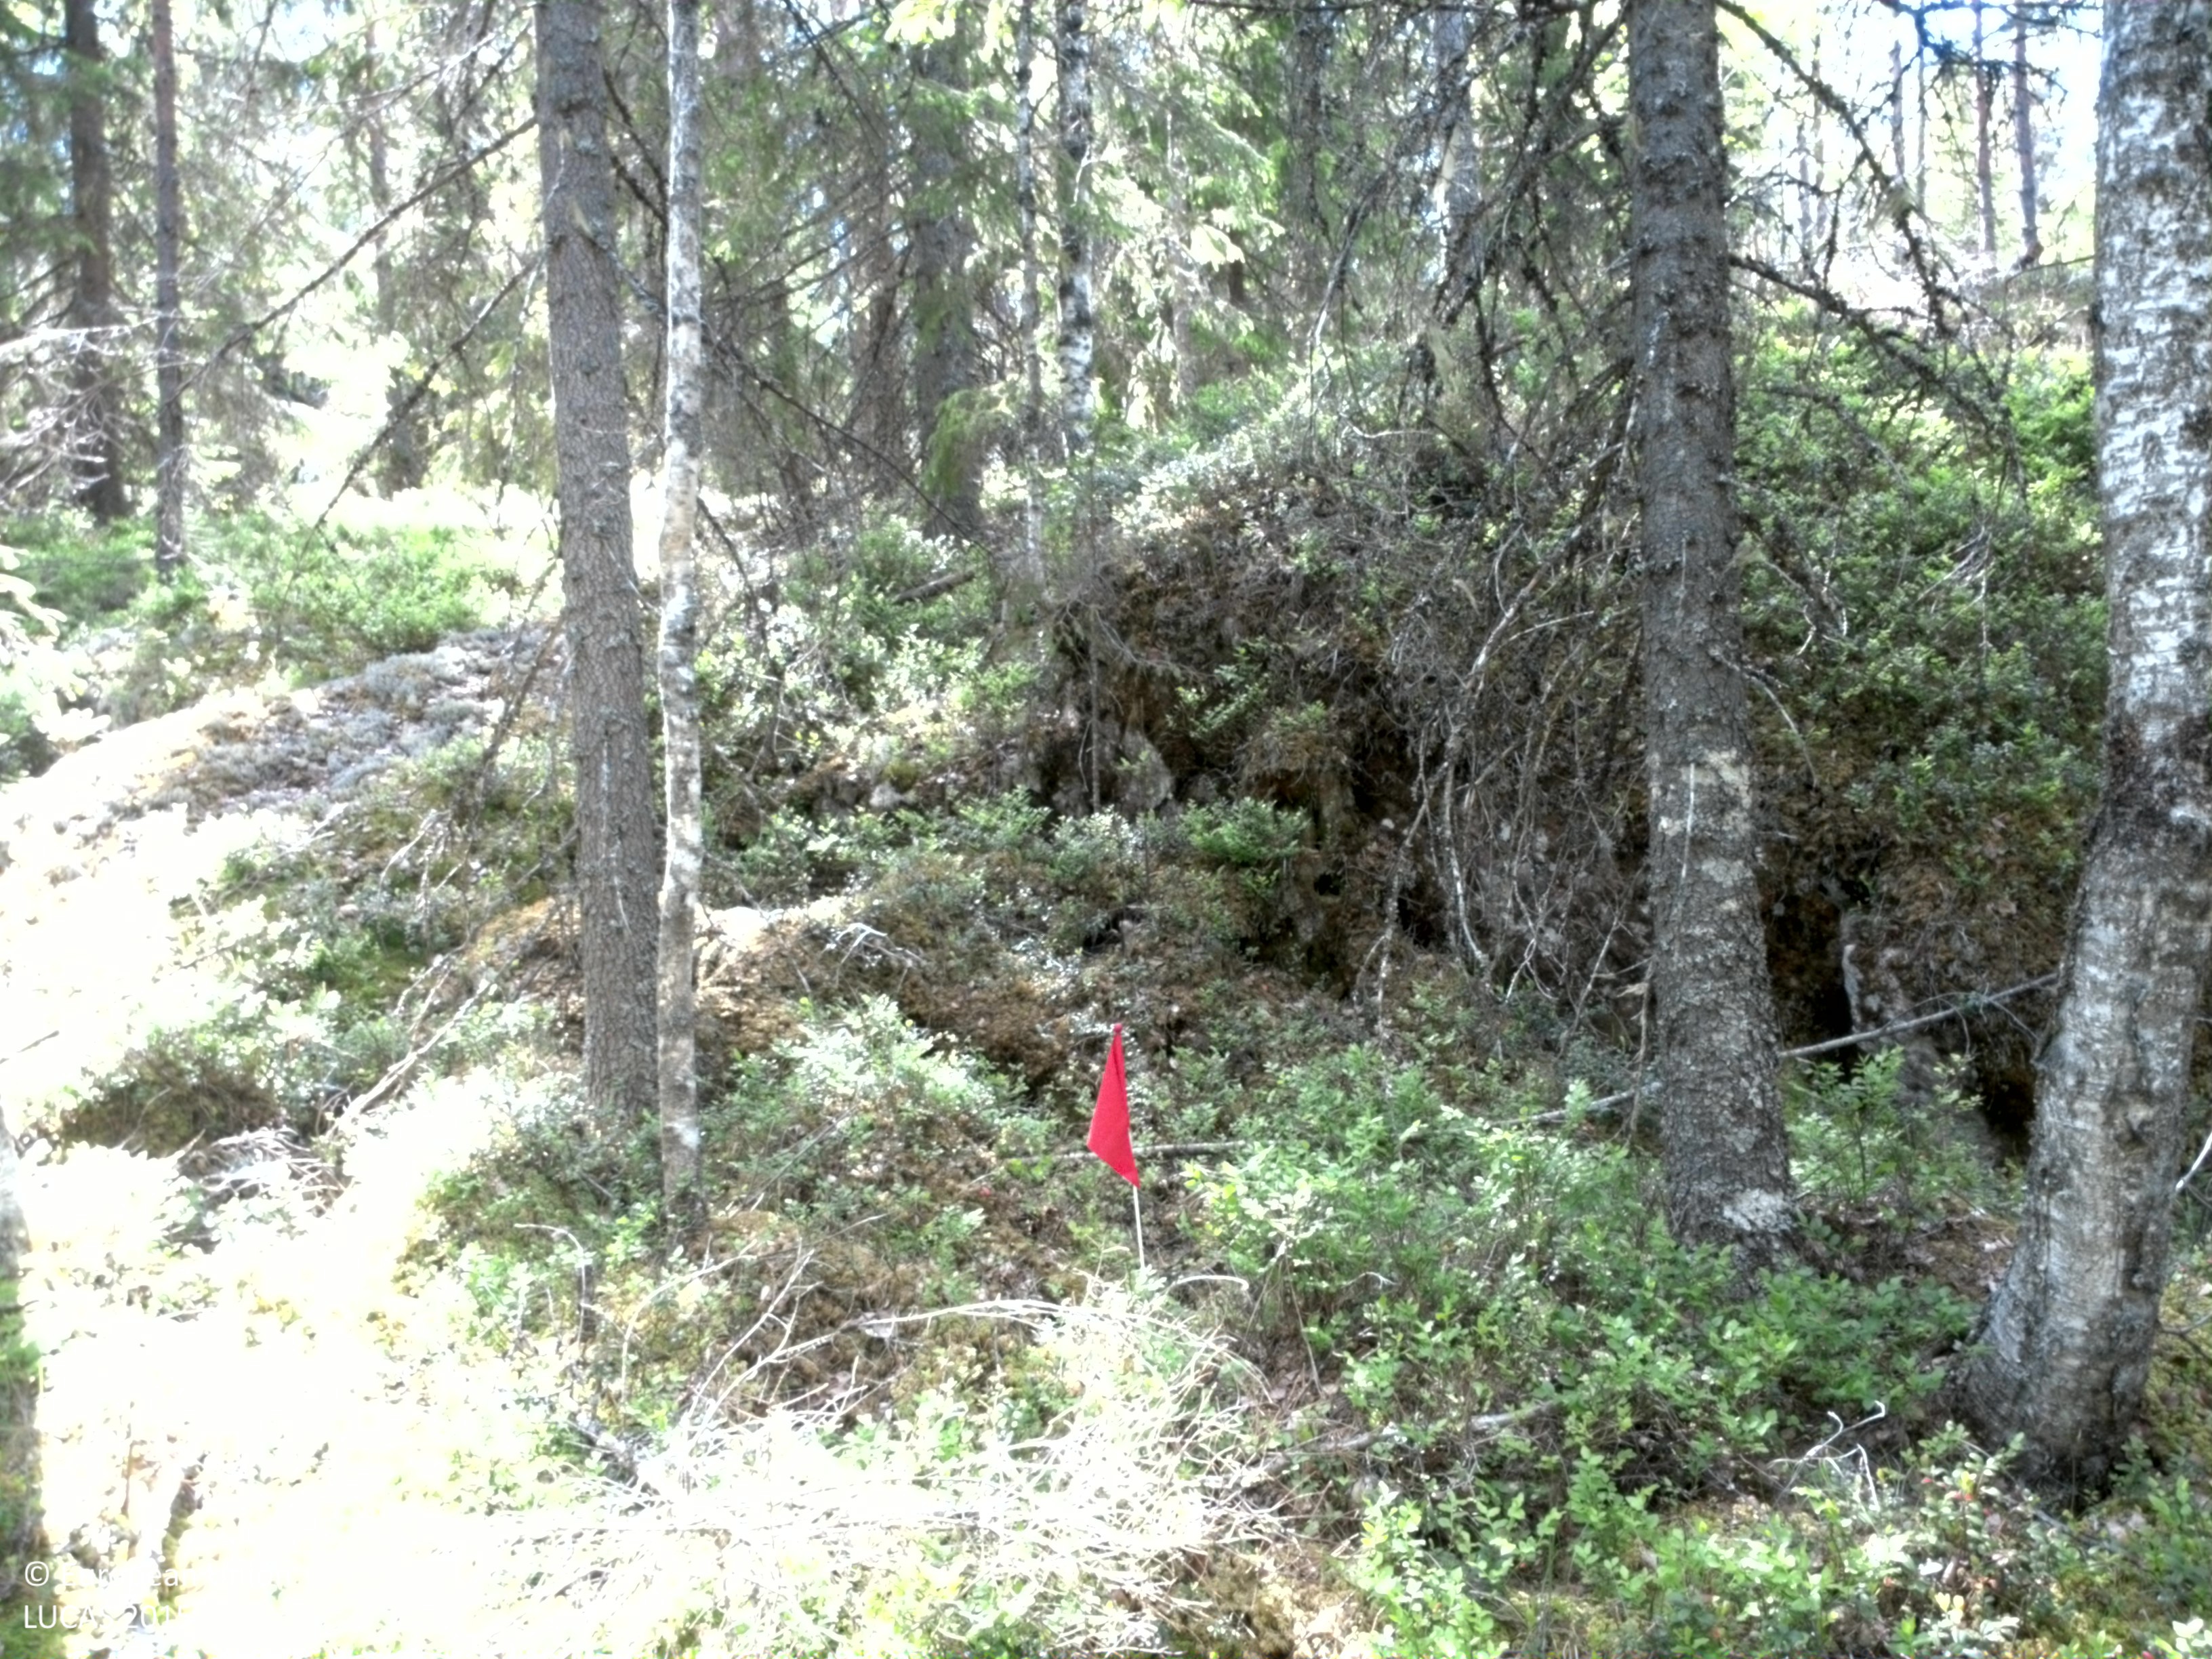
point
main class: Woodland
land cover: Pine dominated mixed woodland
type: boreal forest
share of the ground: 25 - 50 %
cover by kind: coniferous forest trees 35 %, lichens and mosses 25 %, shrubs 20 %, broadleaved forest trees 15 %, herbaceous plants 5 %
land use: Forestry
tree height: > 5 m
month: June
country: SE
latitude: 59.6258
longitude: 12.0335
